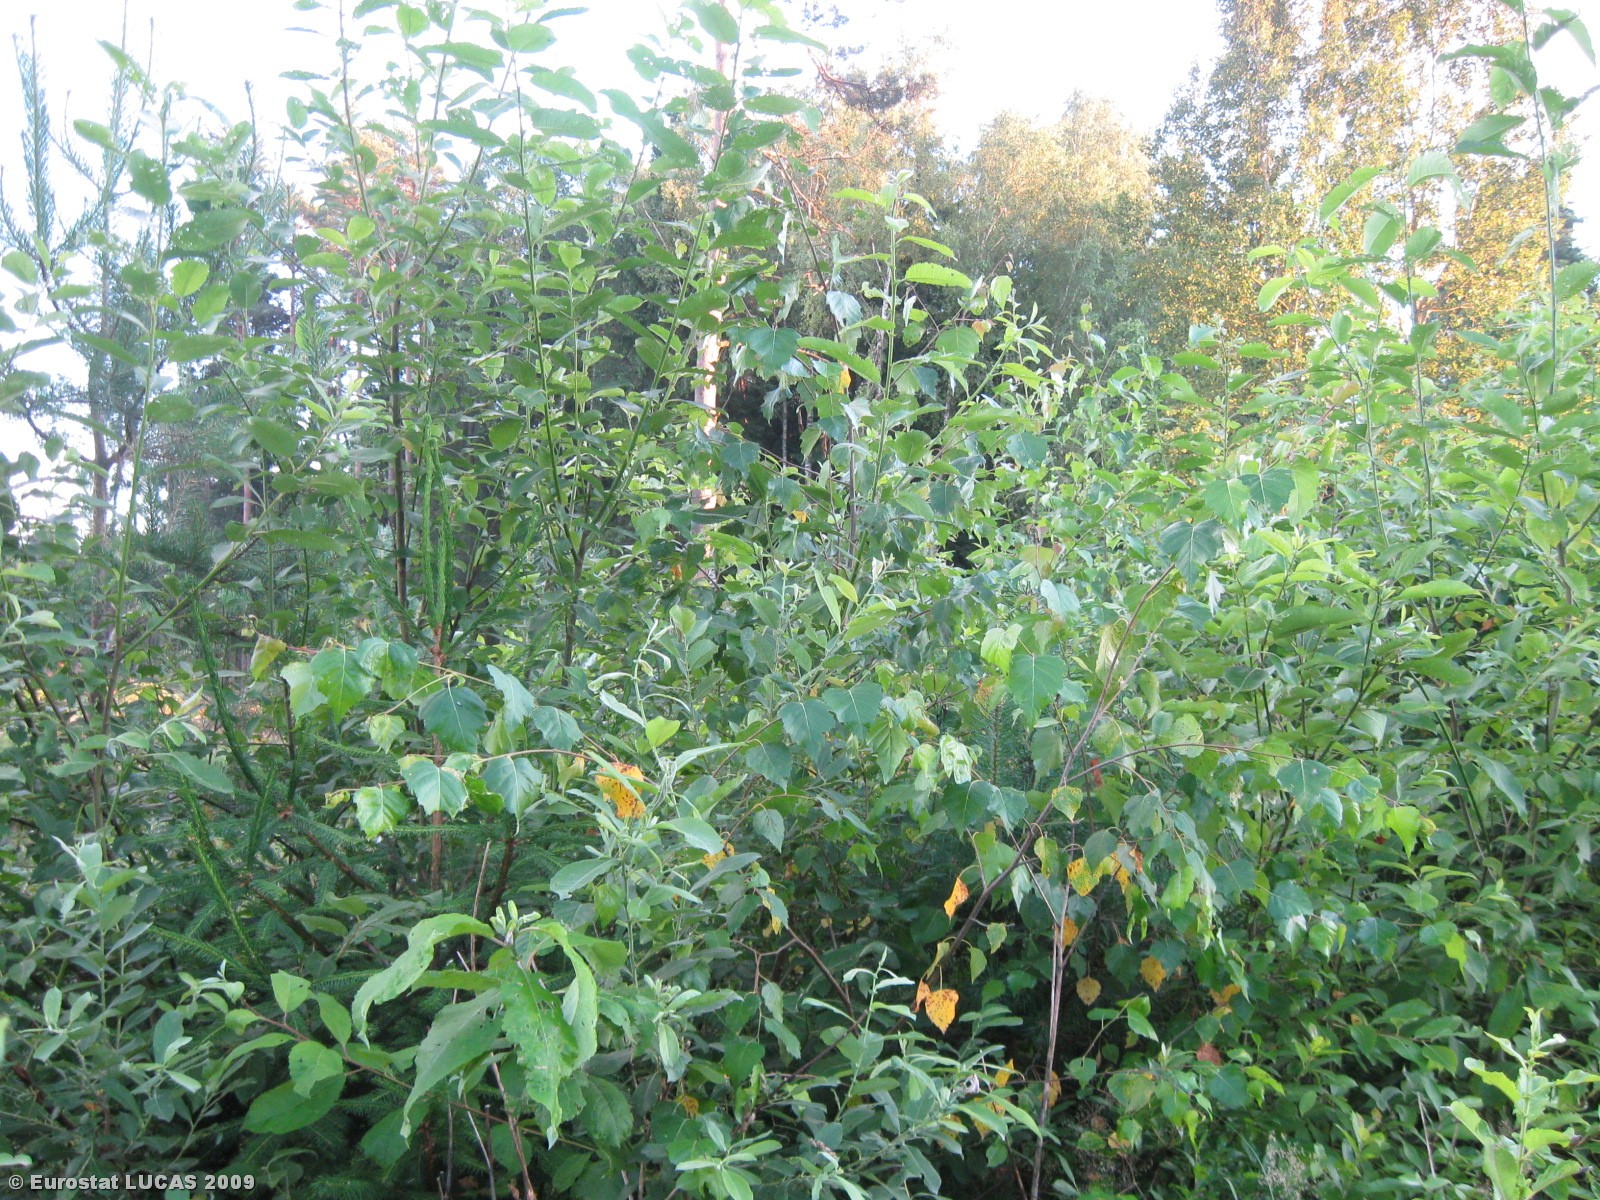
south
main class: Grassland
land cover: Grassland with sparse tree/shrub cover
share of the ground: > 75 %
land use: Forestry
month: July
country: LT
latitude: 54.5799
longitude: 25.3314
